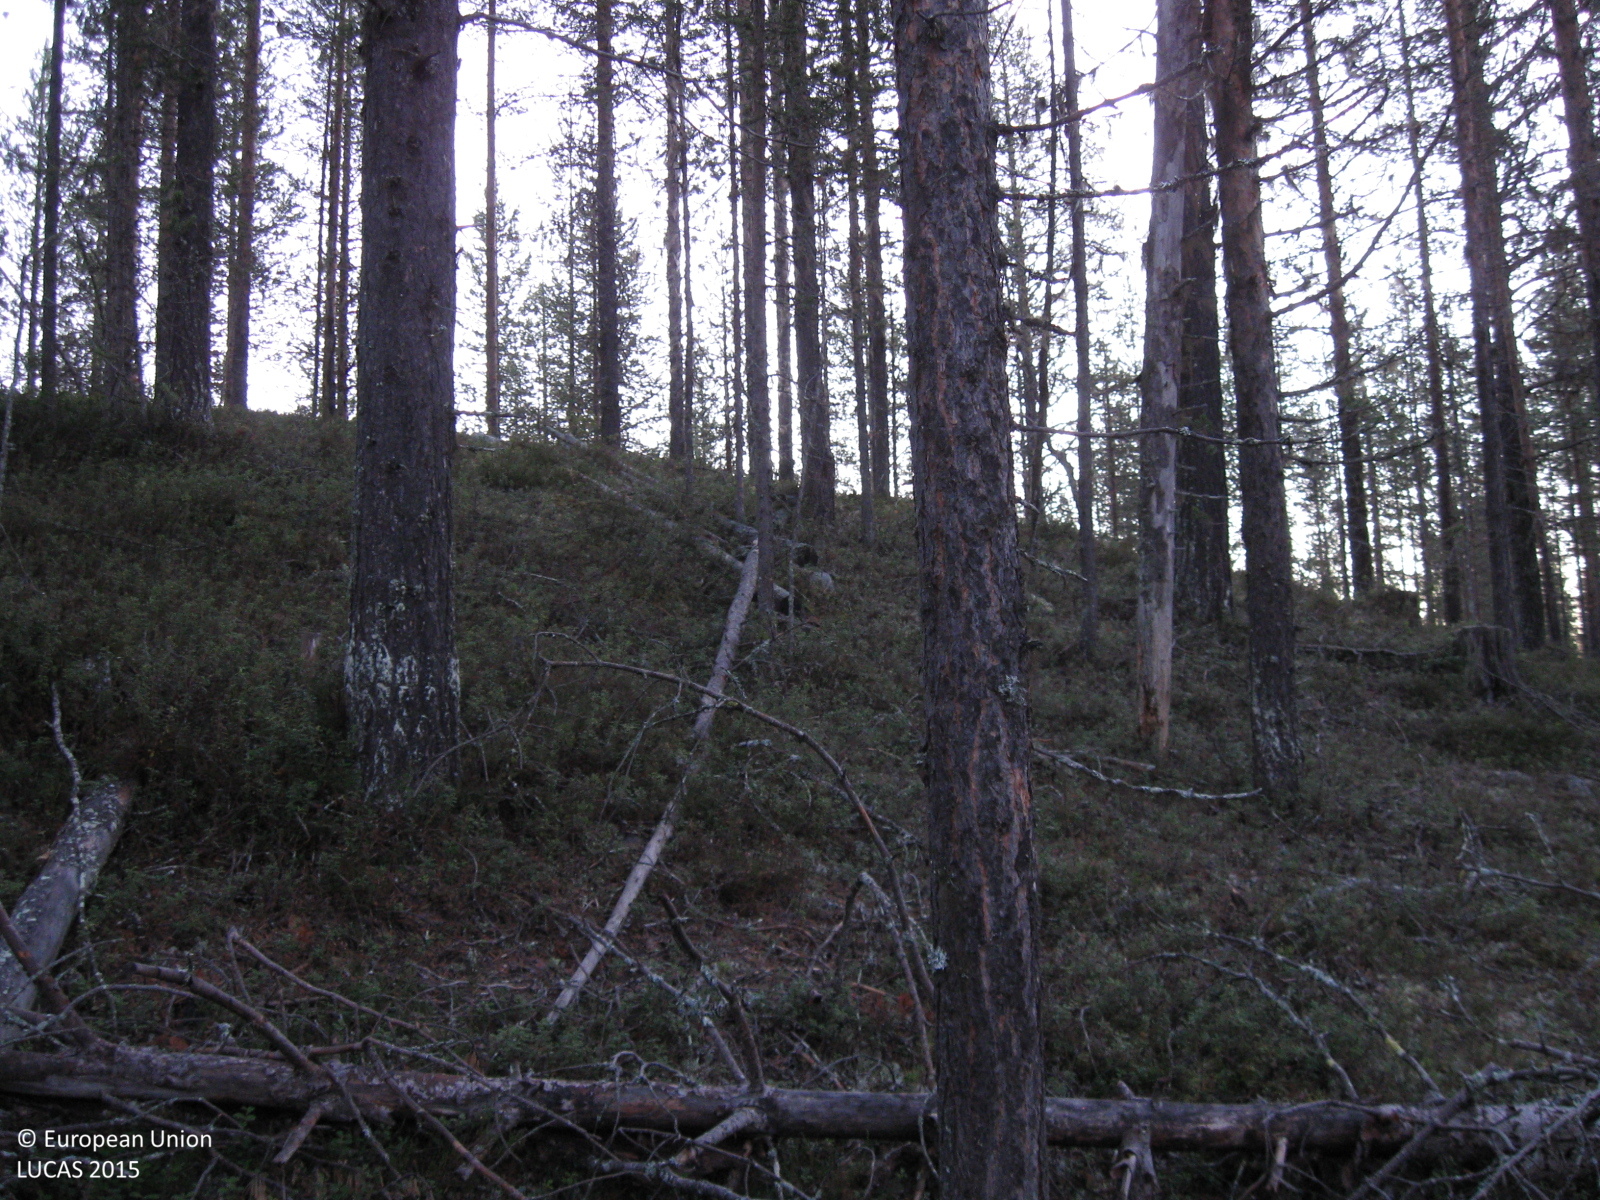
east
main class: Woodland
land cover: Pine dominated coniferous woodland
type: boreal forest
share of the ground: 50 - 75 %
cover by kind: coniferous forest trees 70 %, shrubs 20 %, herbaceous plants 5 %, lichens and mosses 5 %
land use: Forestry
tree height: > 5 m
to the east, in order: Pine dominated coniferous woodland; Tracks; Pine dominated coniferous woodland; Lichens and moss; Paved roads, cycling and walking lanes; Pine dominated mixed woodland
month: October
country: SE
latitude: 66.4847
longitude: 20.9871
